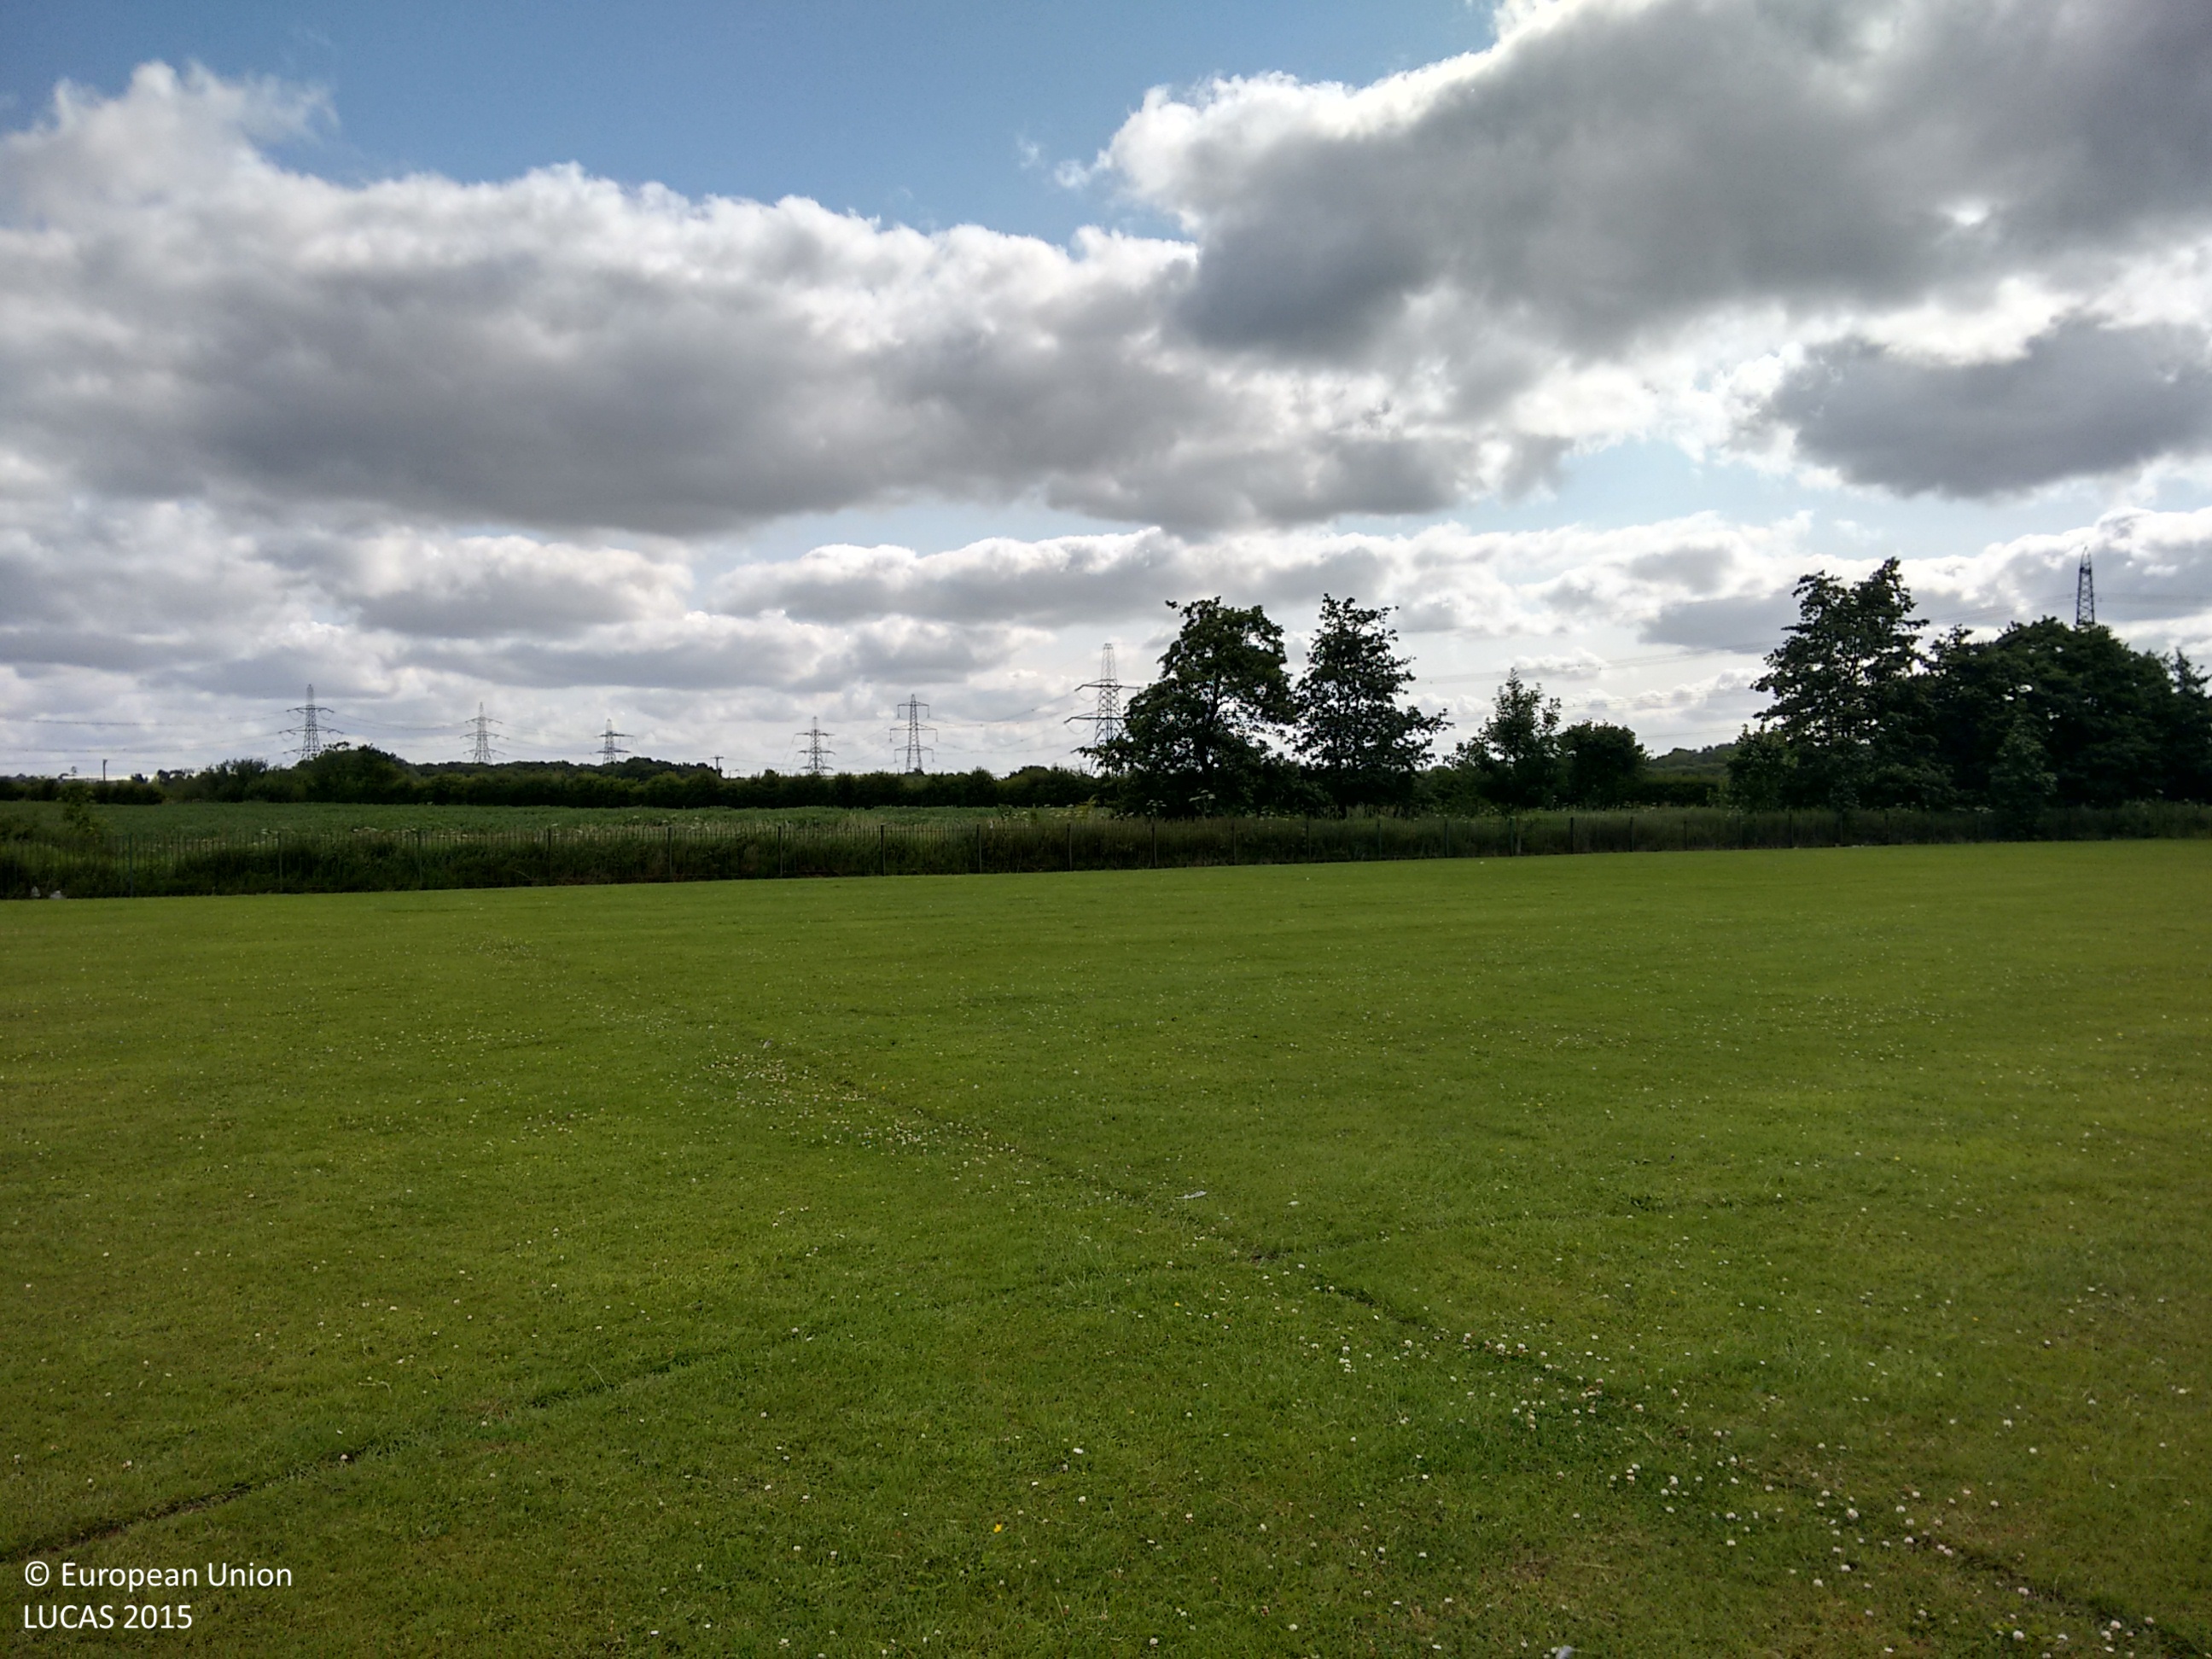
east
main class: Grassland
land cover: Grassland without tree/shrub cover
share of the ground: > 75 %
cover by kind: herbaceous plants 100 %
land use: Sport
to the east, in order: Grassland without tree/shrub cover; Fences; Grass margins; Ditches and canals; Grass margins; Sugar beet; Grass margins; Ditches and canals; Grassland without tree/shrub cover
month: July
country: GB
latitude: 53.4162
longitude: -2.7535
